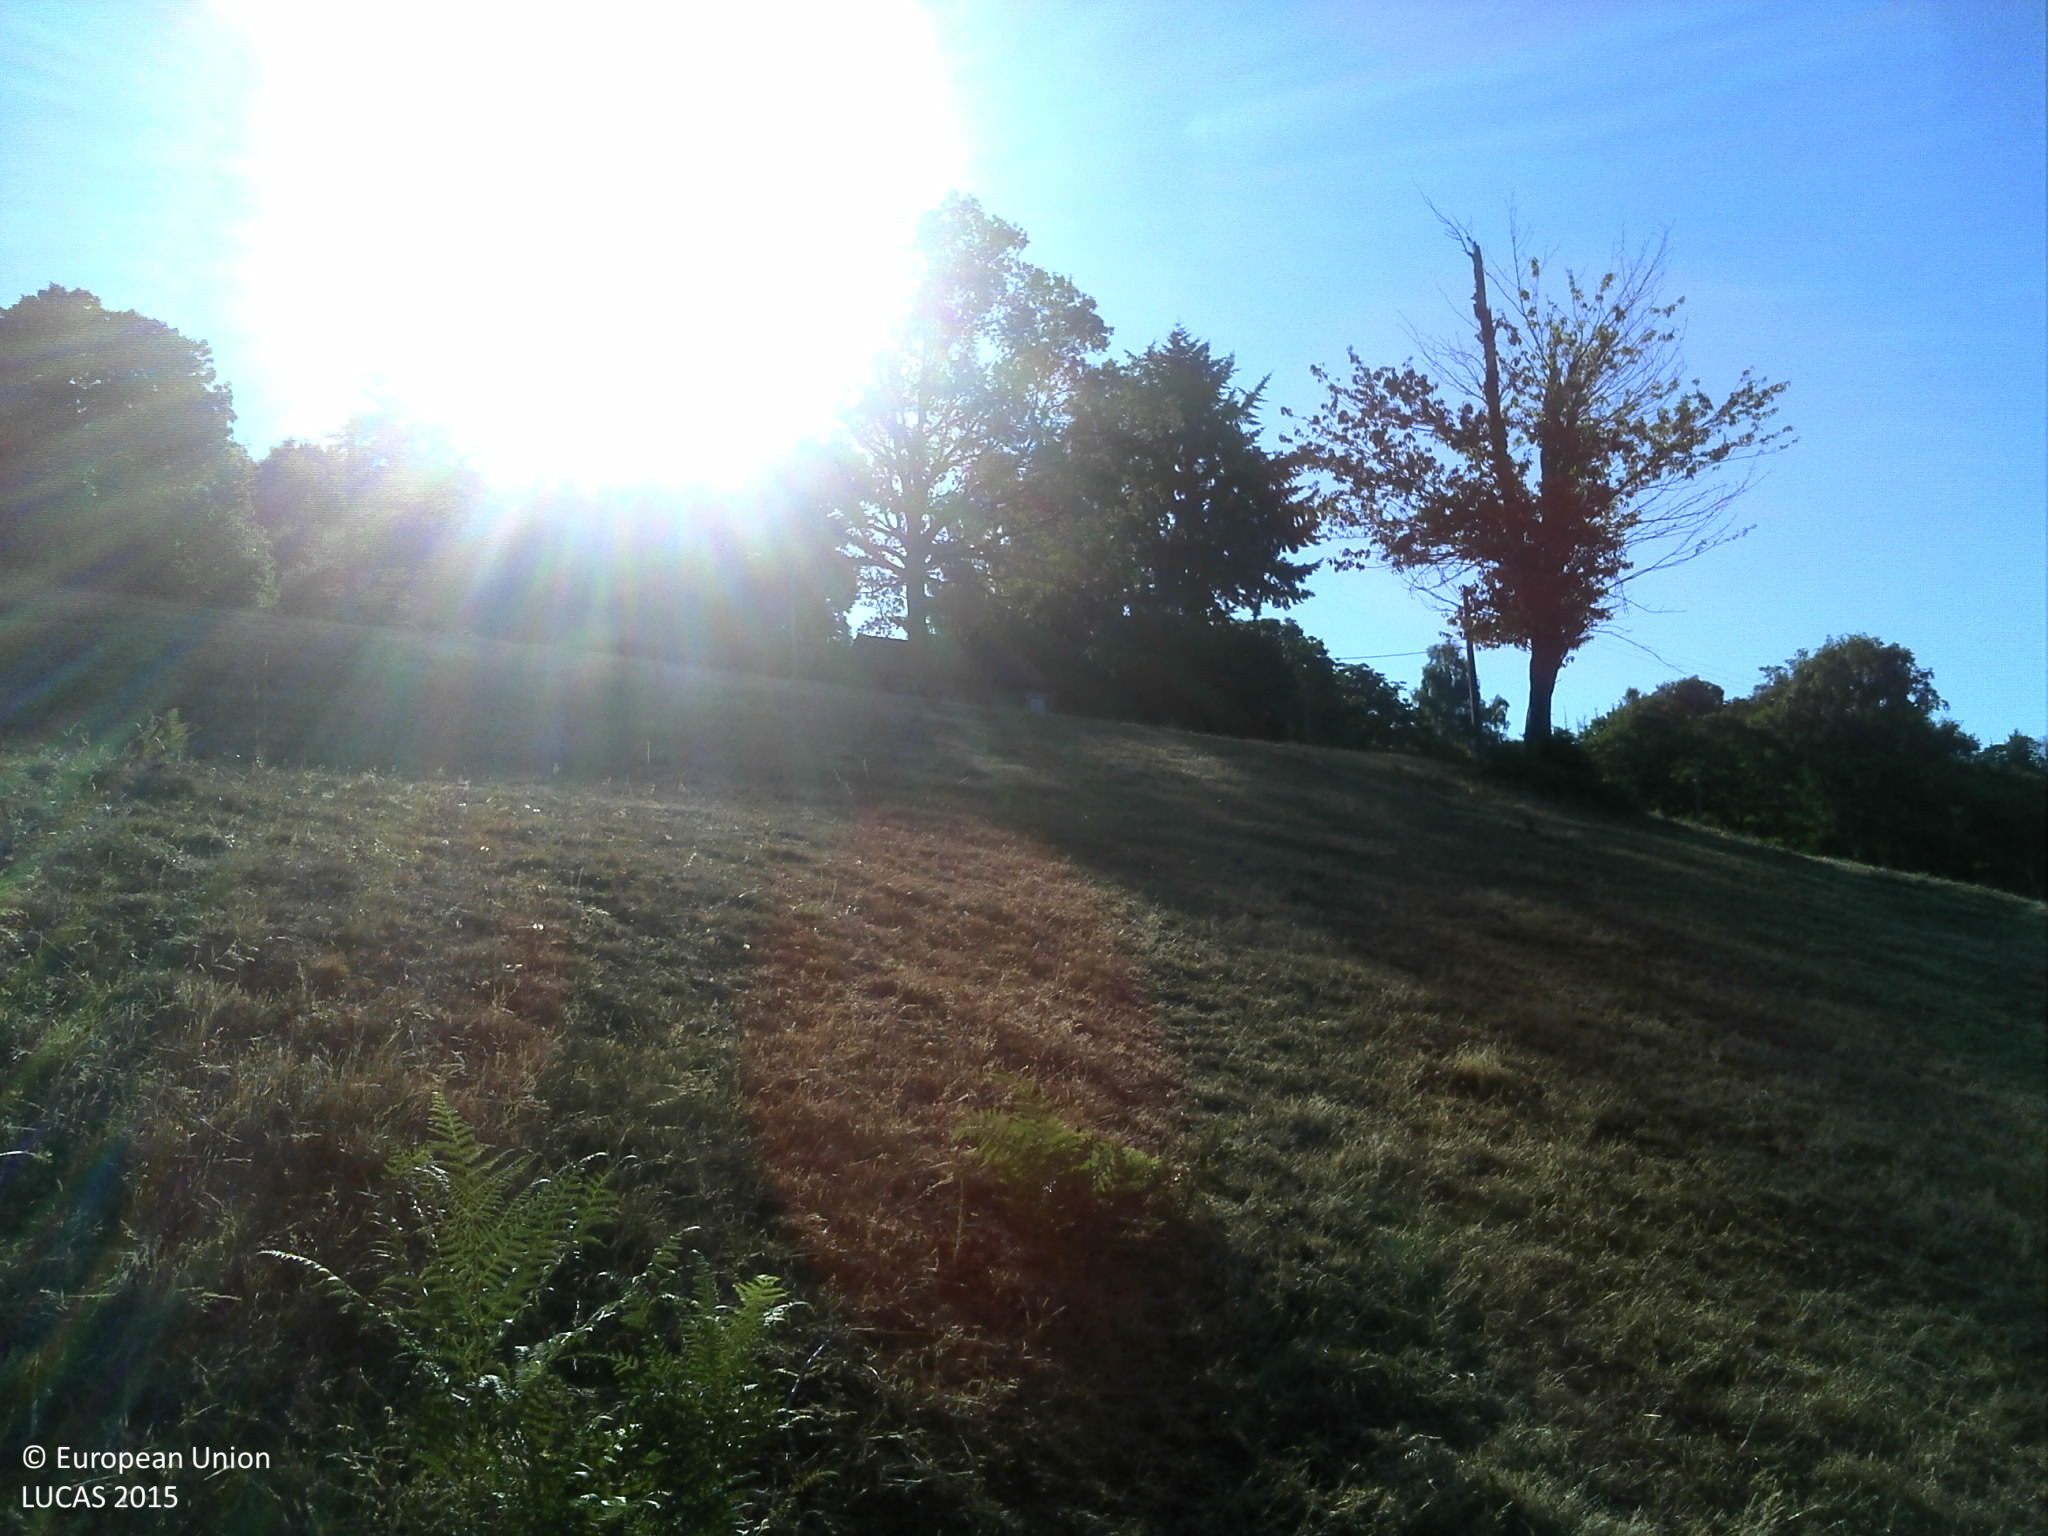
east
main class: Grassland
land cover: Grassland with sparse tree/shrub cover
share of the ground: > 75 %
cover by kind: herbaceous plants 95 %, broadleaved forest trees 5 %
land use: Agriculture (excluding fallow land and kitchen gardens)
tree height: > 5 m
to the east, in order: Grassland with sparse tree/shrub cover; Fences; Grass margins; Artificial constructions in urban areas; Broadleaved woodland; Fences; Grassland without tree/shrub cover; Fences; Grassland without tree/shrub cover
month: July
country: FR
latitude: 45.1085
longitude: 1.7479
